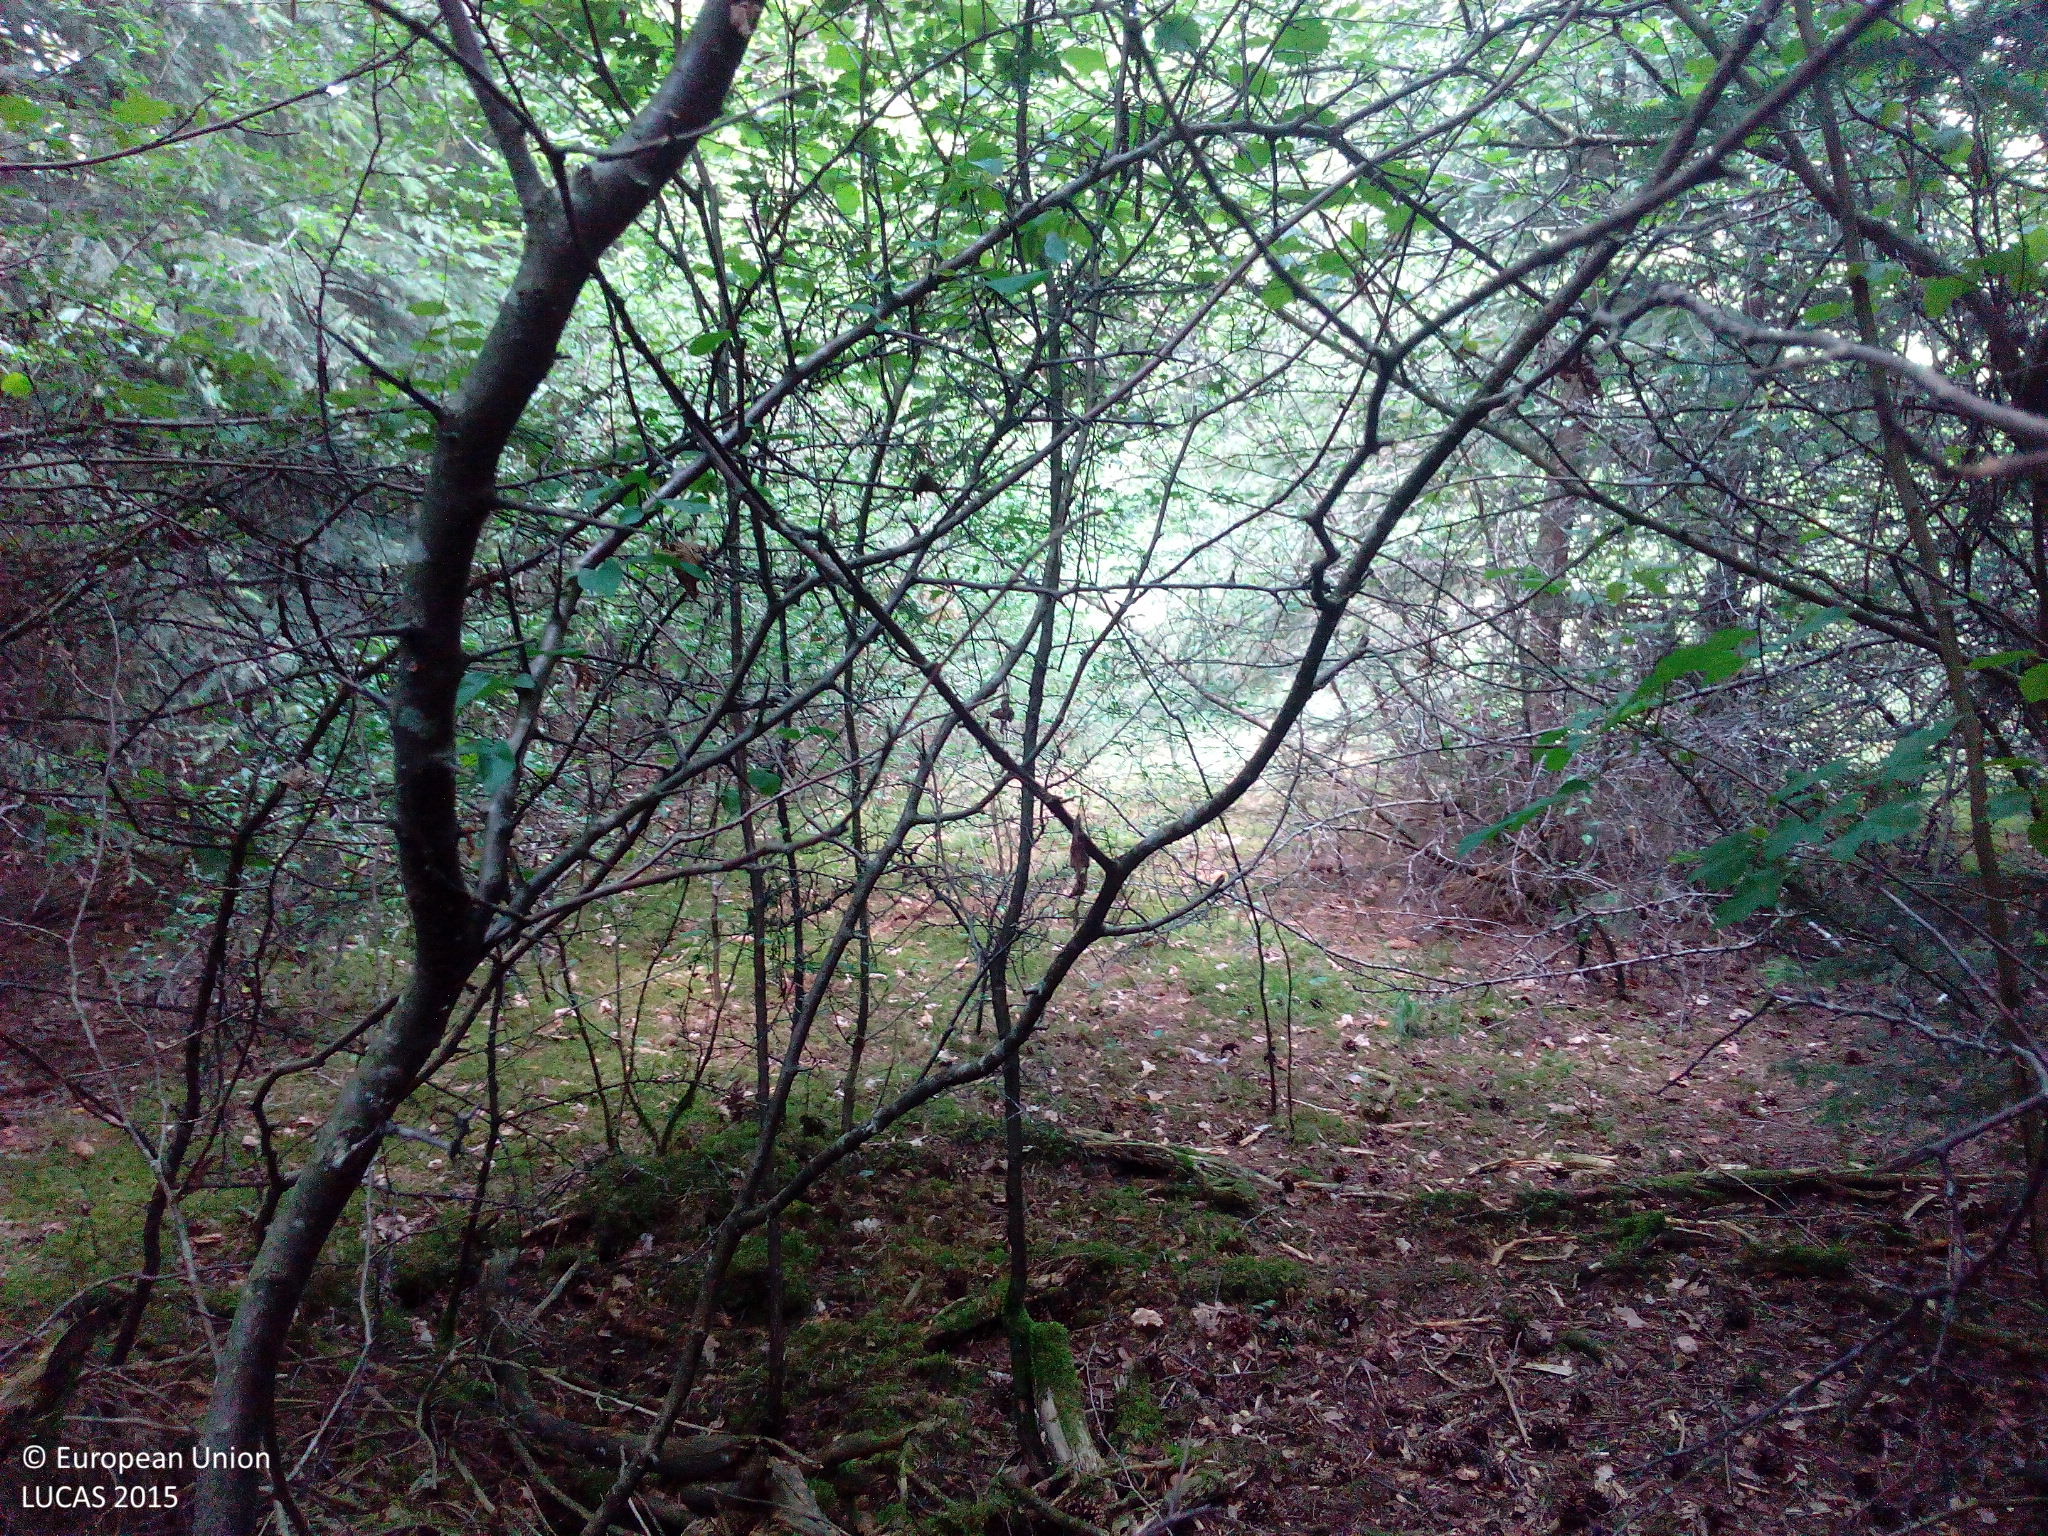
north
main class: Woodland
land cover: Spruce dominated mixed woodland
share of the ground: > 75 %
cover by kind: broadleaved forest trees 55 %, coniferous forest trees 35 %, shrubs 10 %
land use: Semi-natural and natural areas not in use
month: July
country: DE
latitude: 48.4030
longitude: 9.6895
